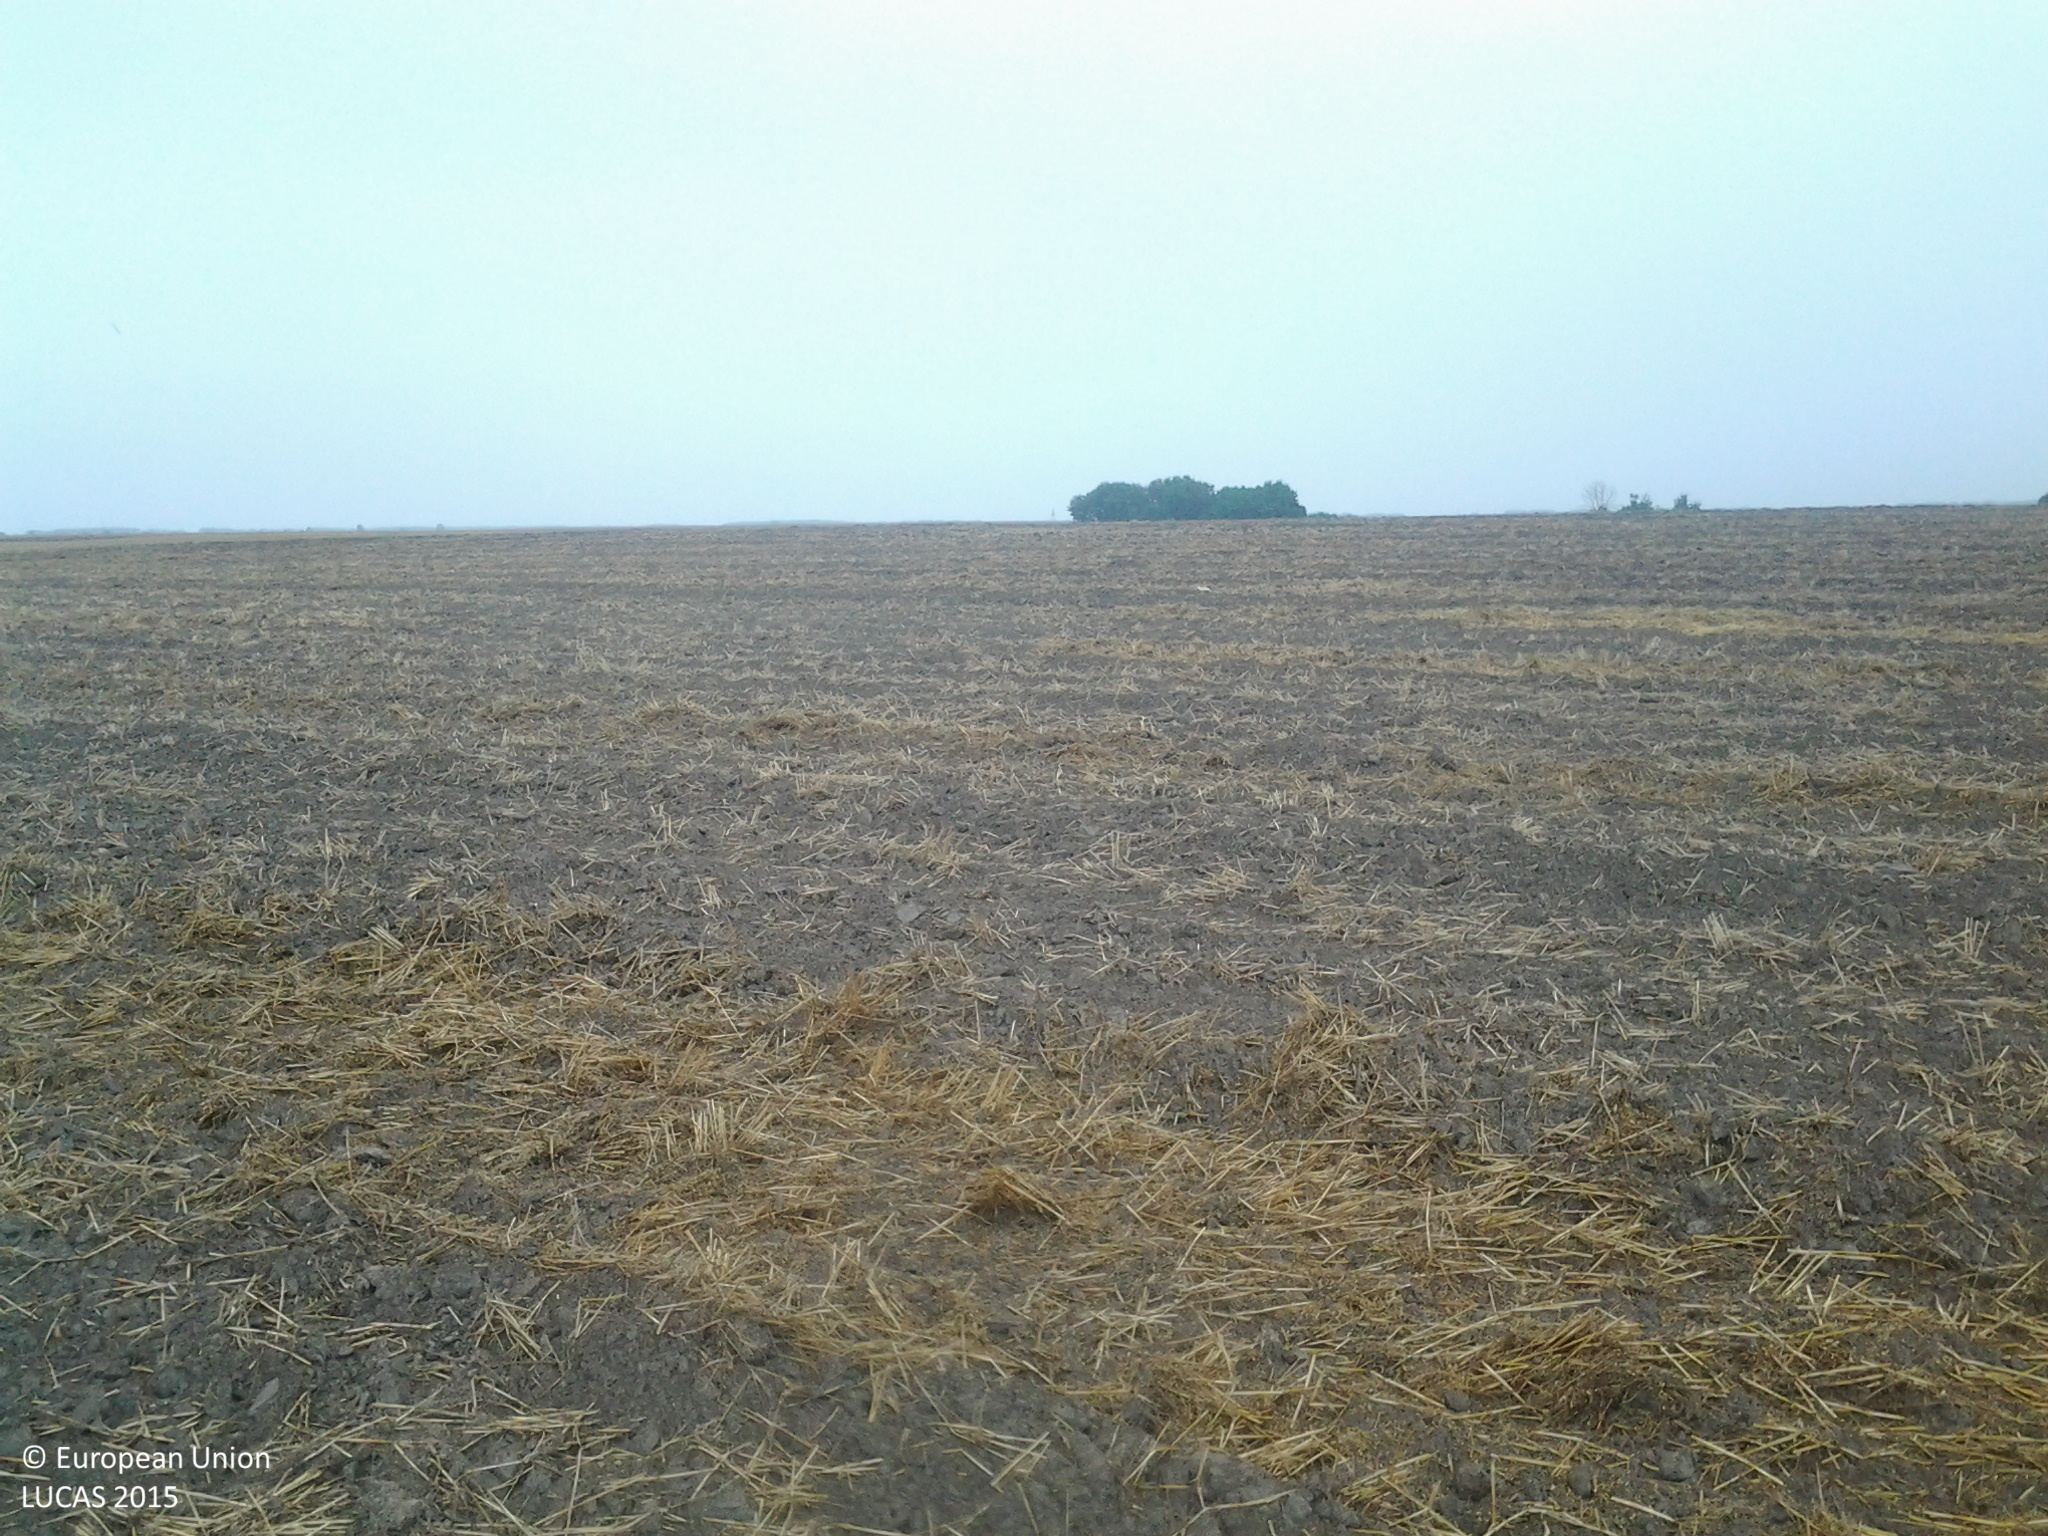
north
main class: Cropland
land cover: Common wheat
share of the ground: < 10 %
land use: Agriculture (excluding fallow land and kitchen gardens)
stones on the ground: < 10 %
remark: Harvested field
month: July
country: HU
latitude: 46.9838
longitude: 19.0215
